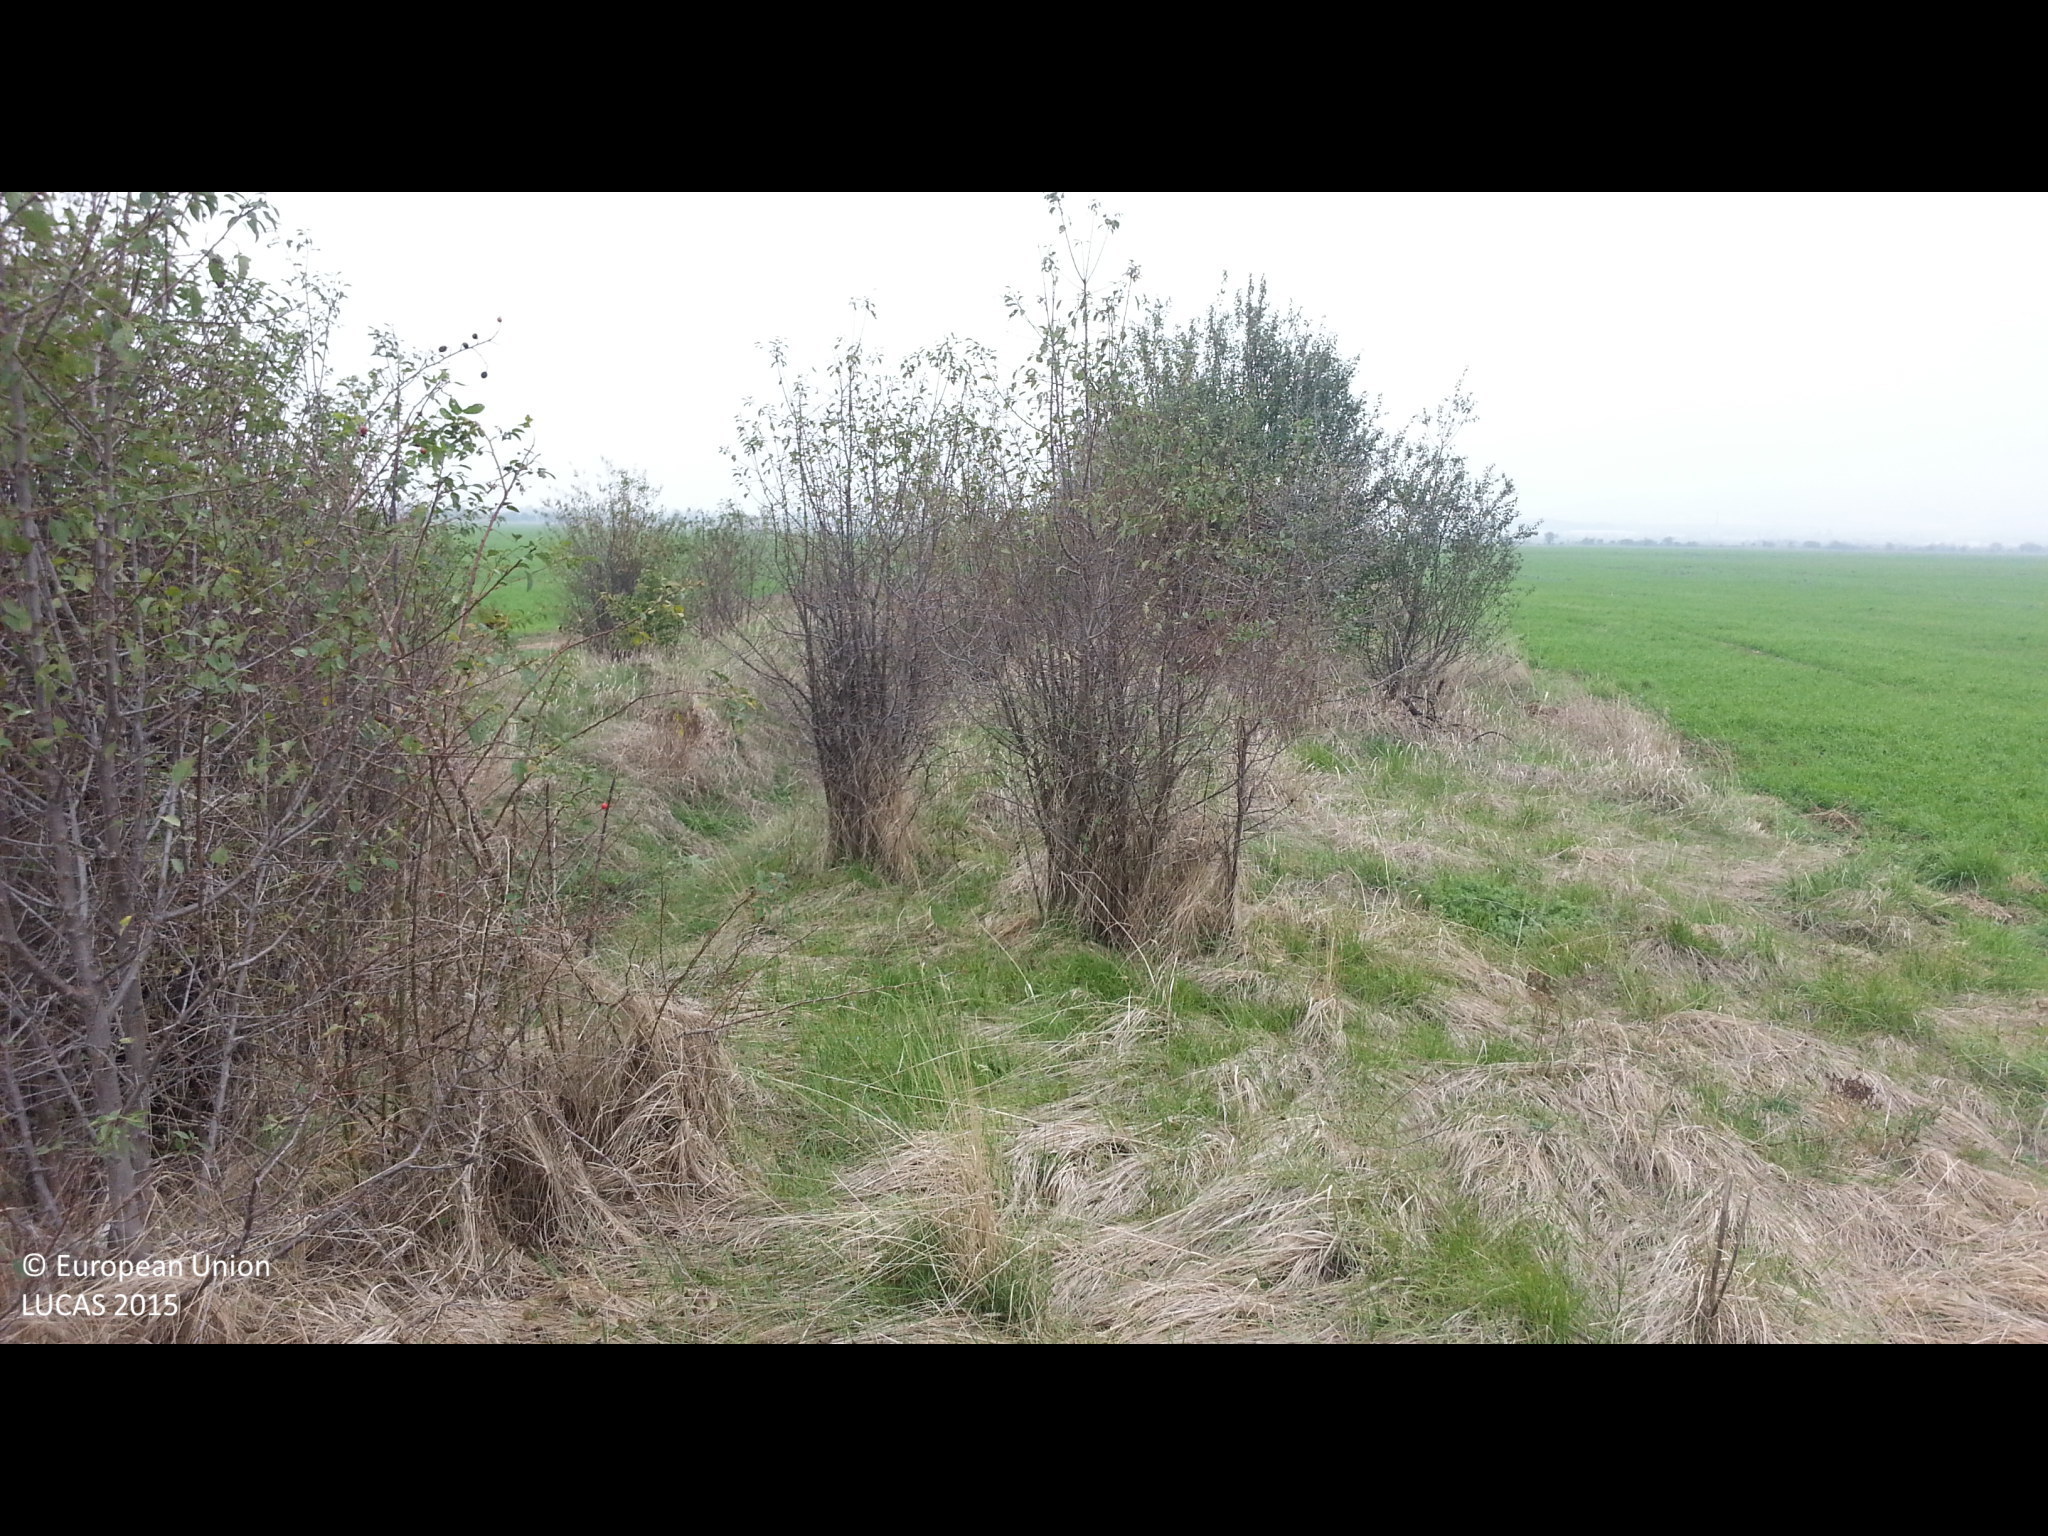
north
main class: Grassland
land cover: Grassland with sparse tree/shrub cover
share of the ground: > 75 %
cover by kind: herbaceous plants 90 %, broadleaved forest trees 5 %, shrubs 5 %
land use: Semi-natural and natural areas not in use
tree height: < 5 m
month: October
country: BG
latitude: 42.6799
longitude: 23.6211
